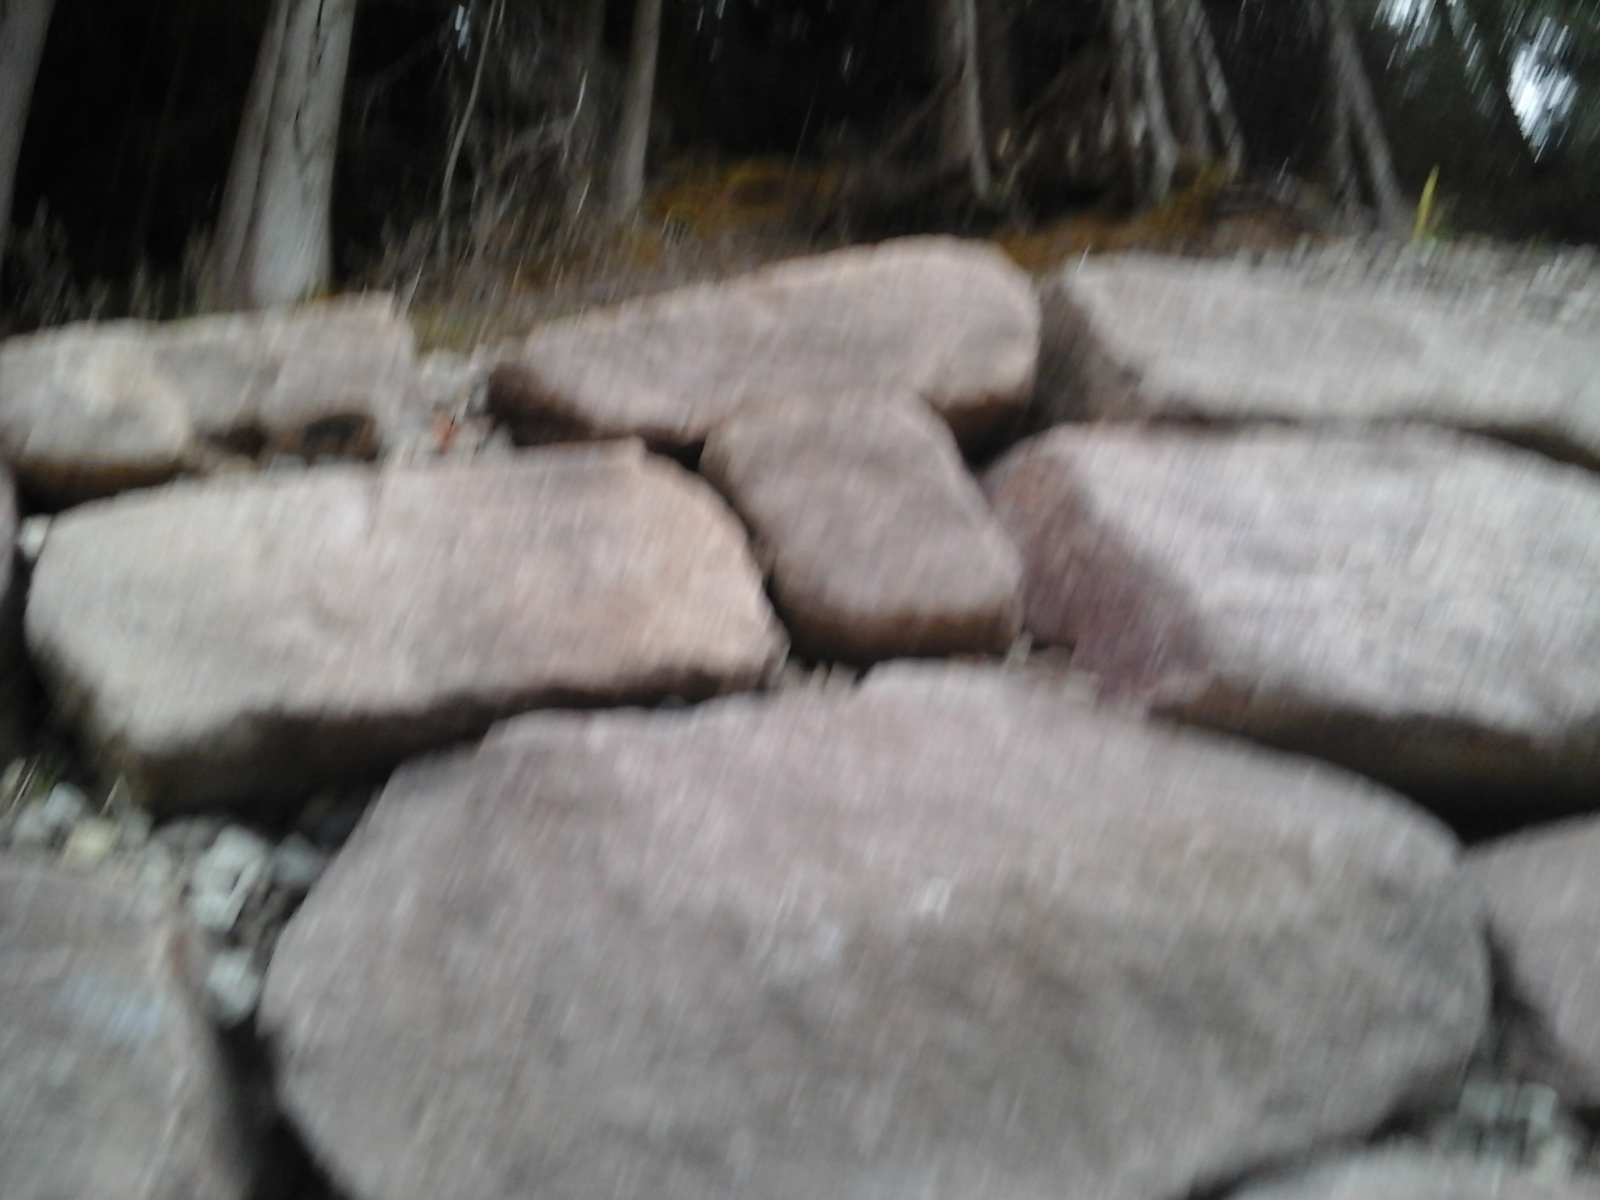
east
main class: Woodland
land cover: Spruce dominated coniferous woodland
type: alpine coniferous forest
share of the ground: > 75 %
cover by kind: coniferous forest trees 95 %, herbaceous plants 5 %
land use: Forestry
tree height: > 5 m
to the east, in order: Spruce dominated coniferous woodland; Tracks; Spruce dominated coniferous woodland
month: May
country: IT
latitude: 46.4301
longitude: 11.5467
